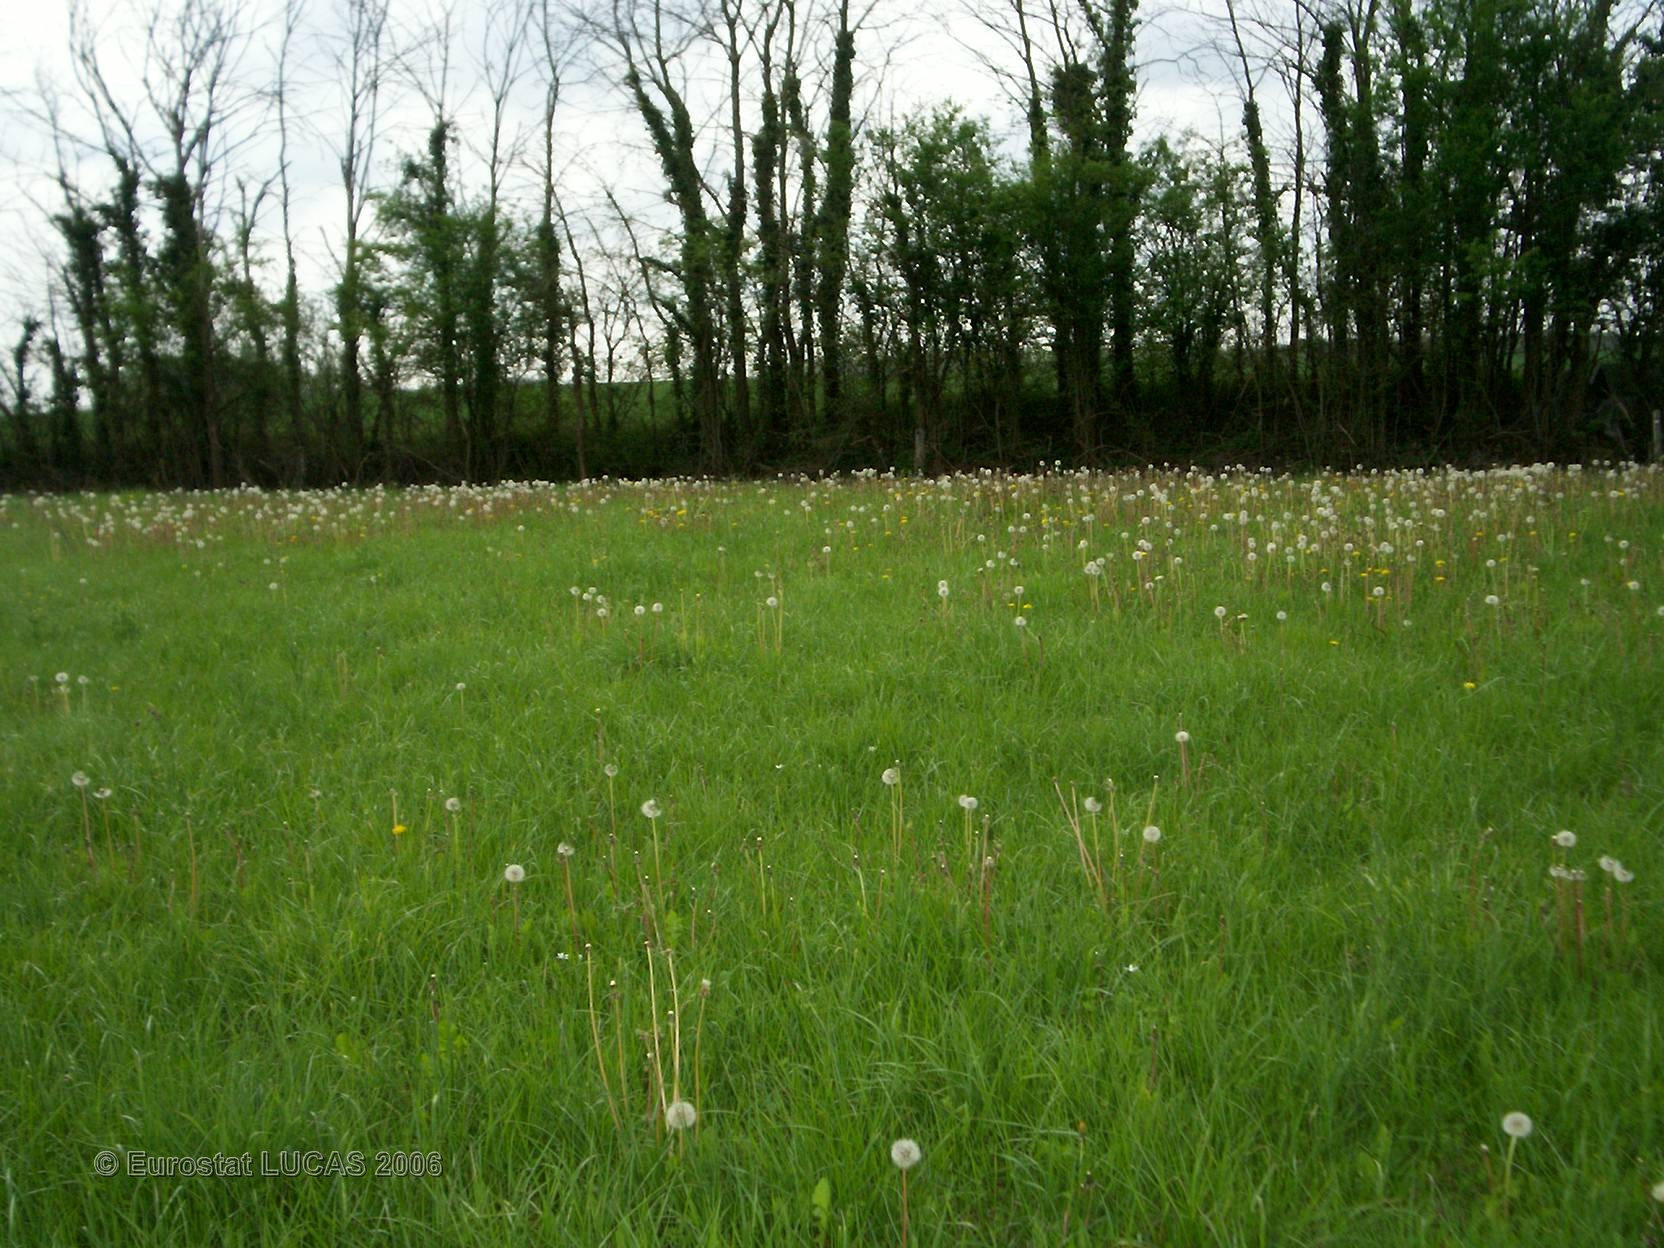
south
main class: Grassland
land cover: Grassland without tree/shrub cover
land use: Agriculture (excluding fallow land and kitchen gardens)
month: April
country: FR
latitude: 46.9985
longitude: 0.3131
